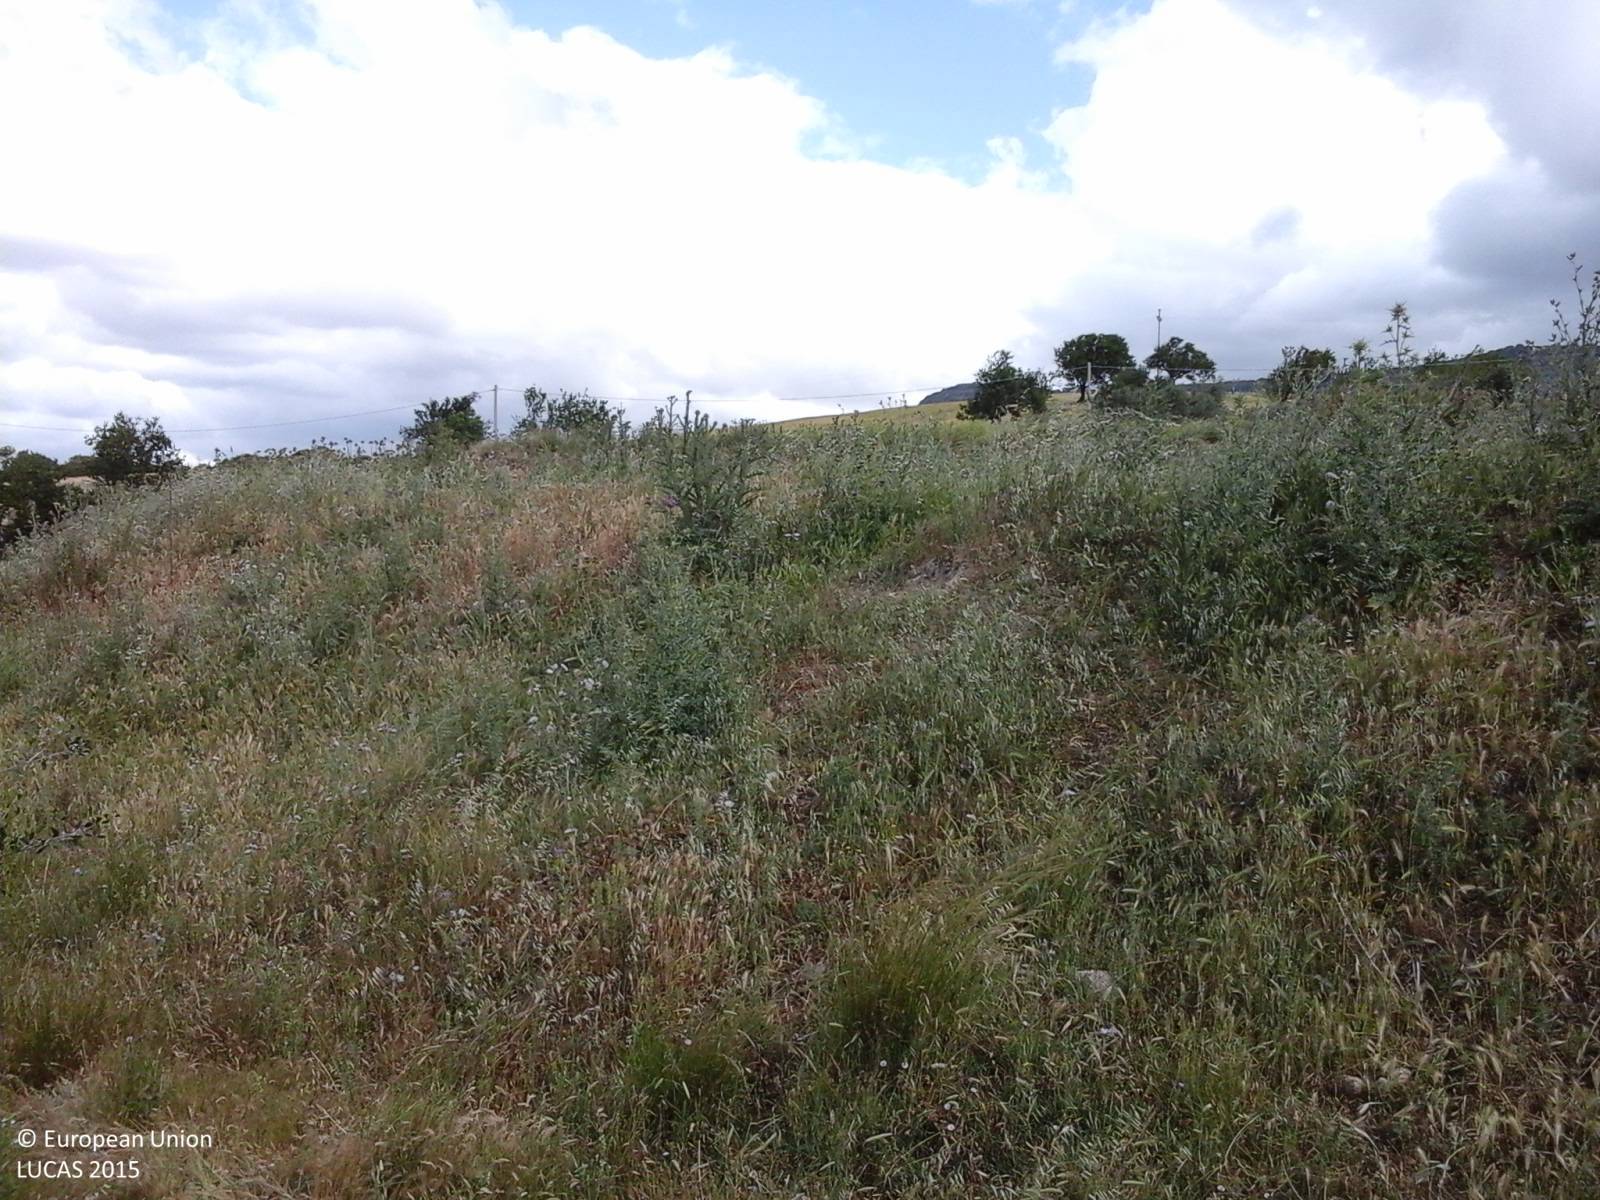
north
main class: Grassland
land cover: Spontaneously vegetated surfaces
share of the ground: > 75 %
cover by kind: herbaceous plants 95 %, shrubs 5 %
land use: Agriculture (excluding fallow land and kitchen gardens)
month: May
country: IT
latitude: 39.7541
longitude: 8.8975
